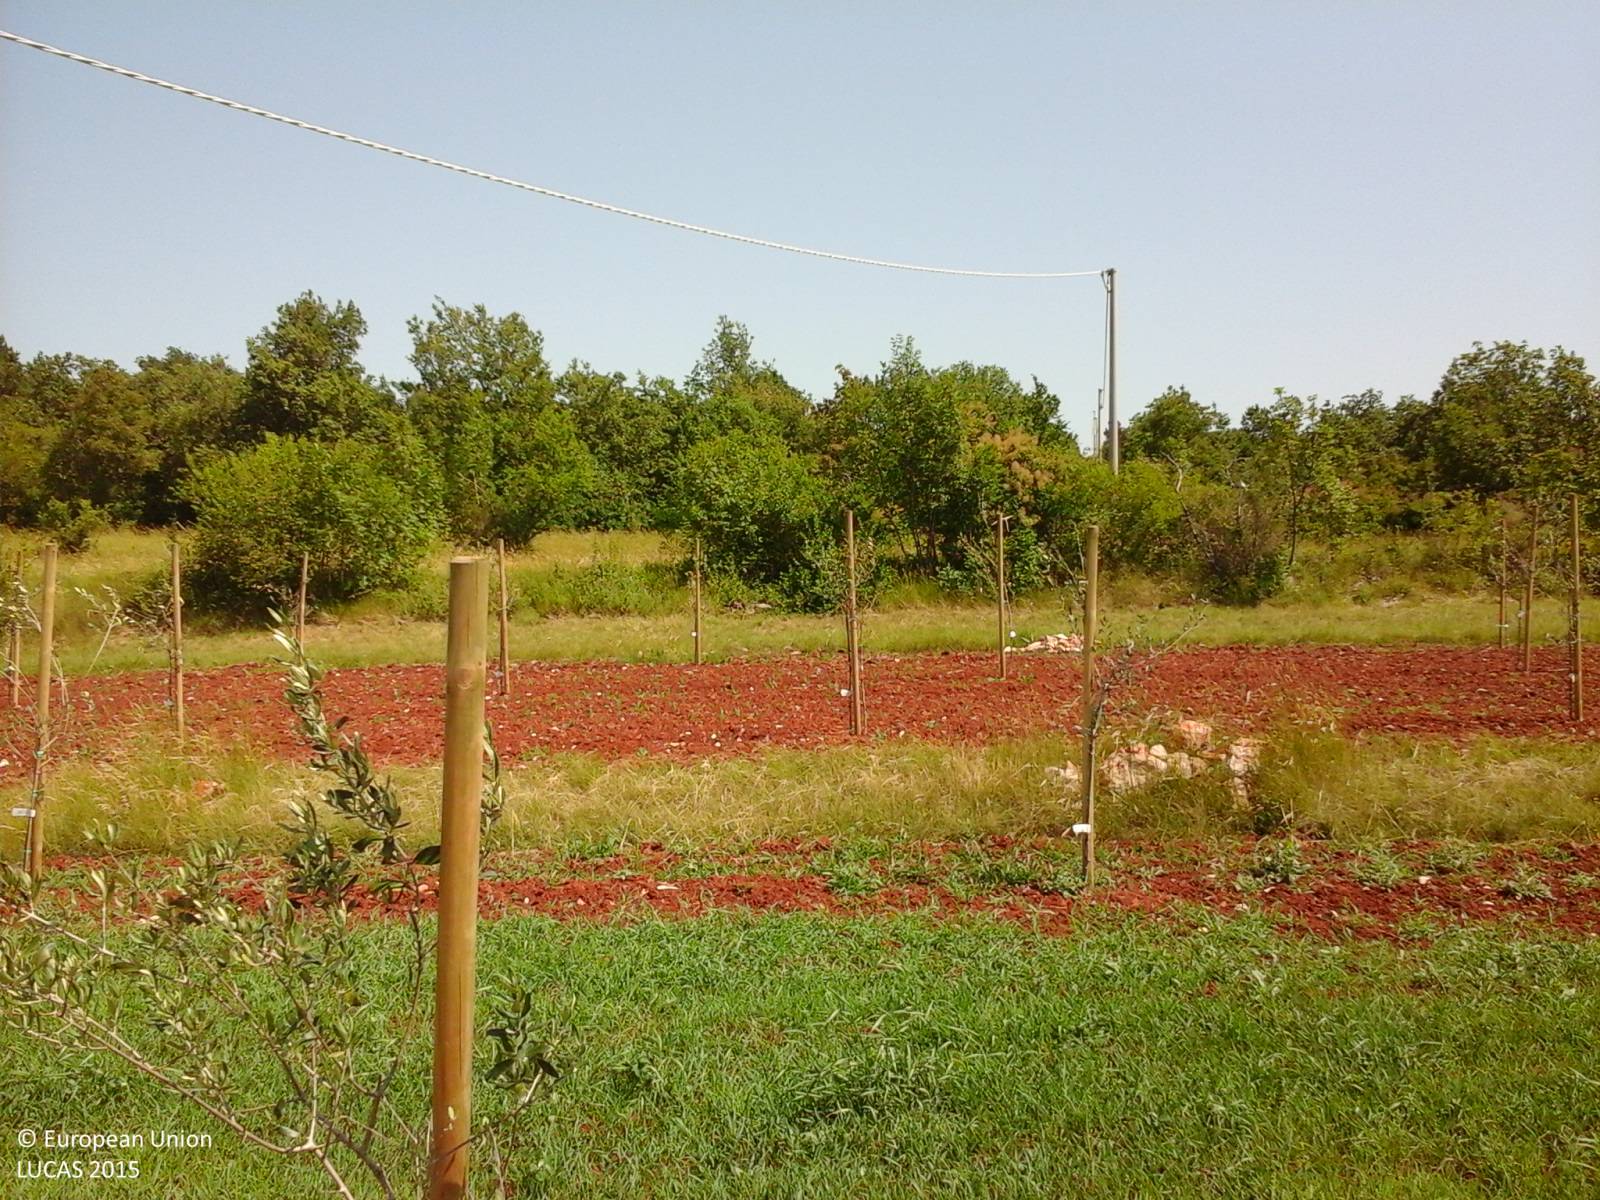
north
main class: Cropland
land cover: Olive groves
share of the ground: 25 - 50 %
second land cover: Grassland without tree/shrub cover
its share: 10 - 25 %
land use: Agriculture (excluding fallow land and kitchen gardens)
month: June
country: IT
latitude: 45.8780
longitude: 13.5392
